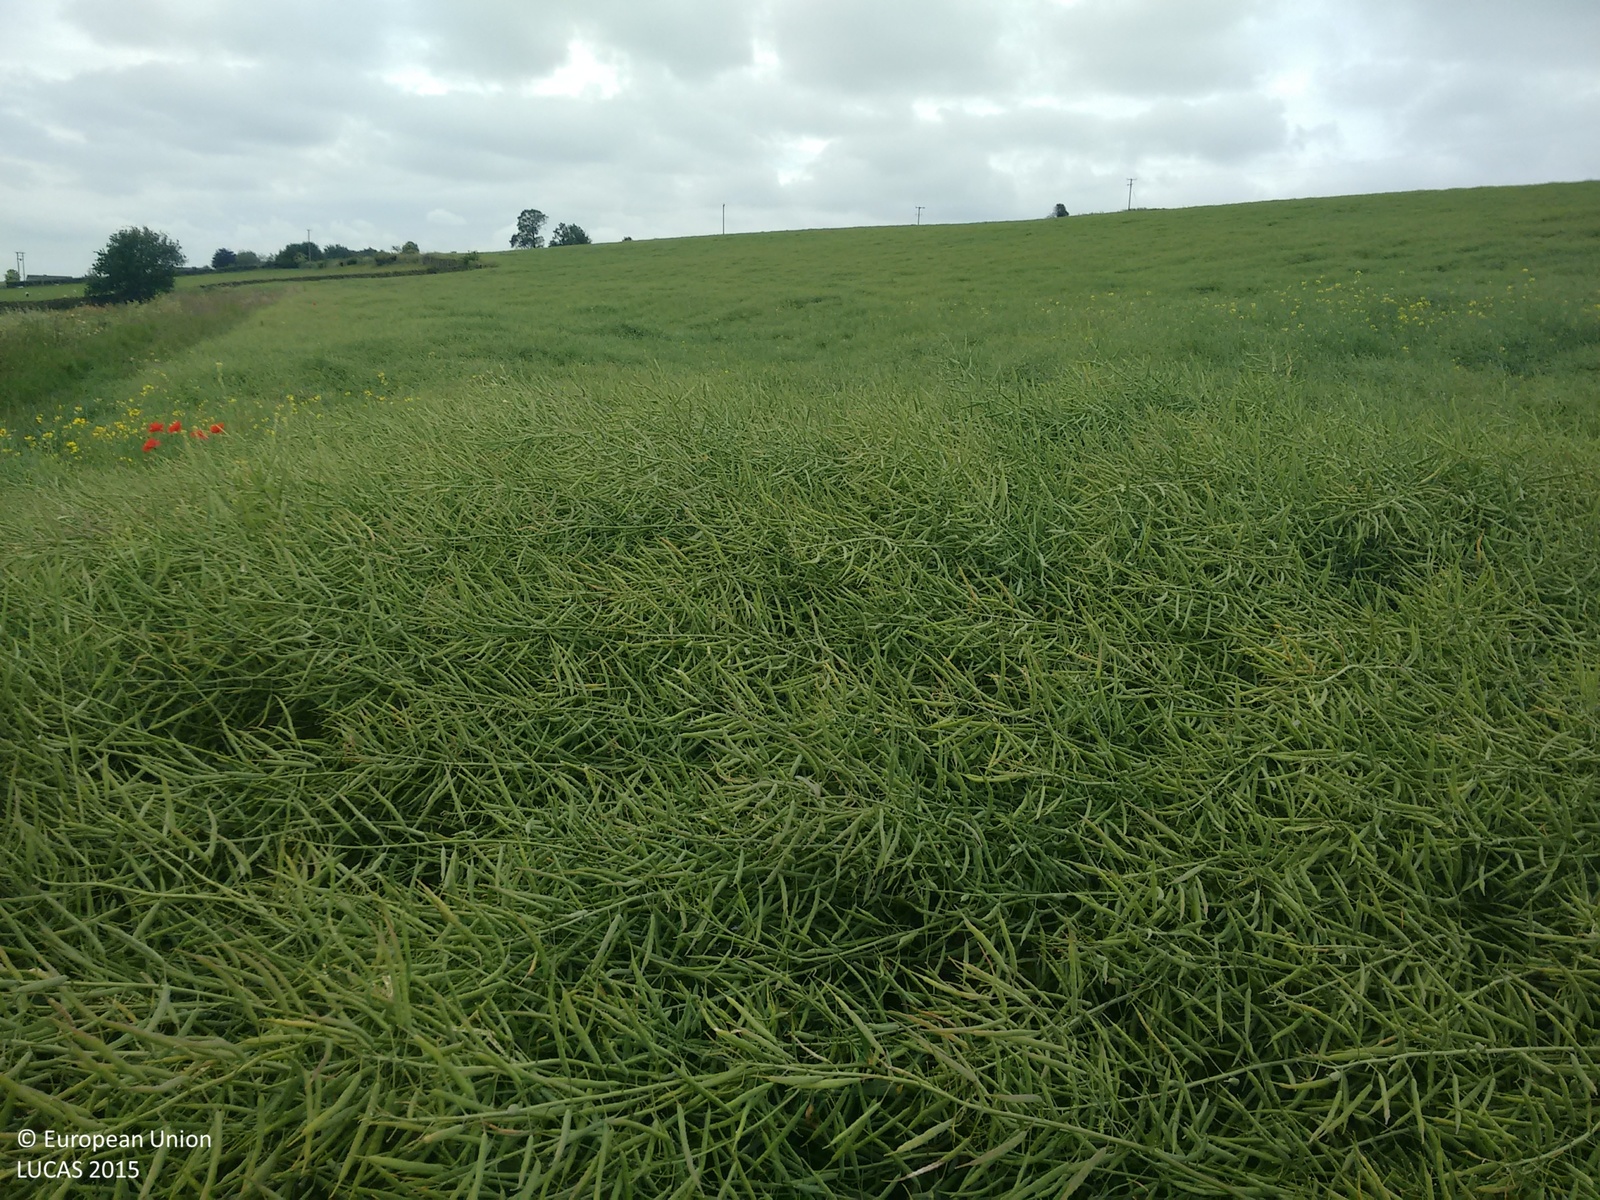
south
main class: Cropland
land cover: Rape and turnip rape
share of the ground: > 75 %
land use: Agriculture (excluding fallow land and kitchen gardens)
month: June
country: GB
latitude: 53.2707
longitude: -1.4911
